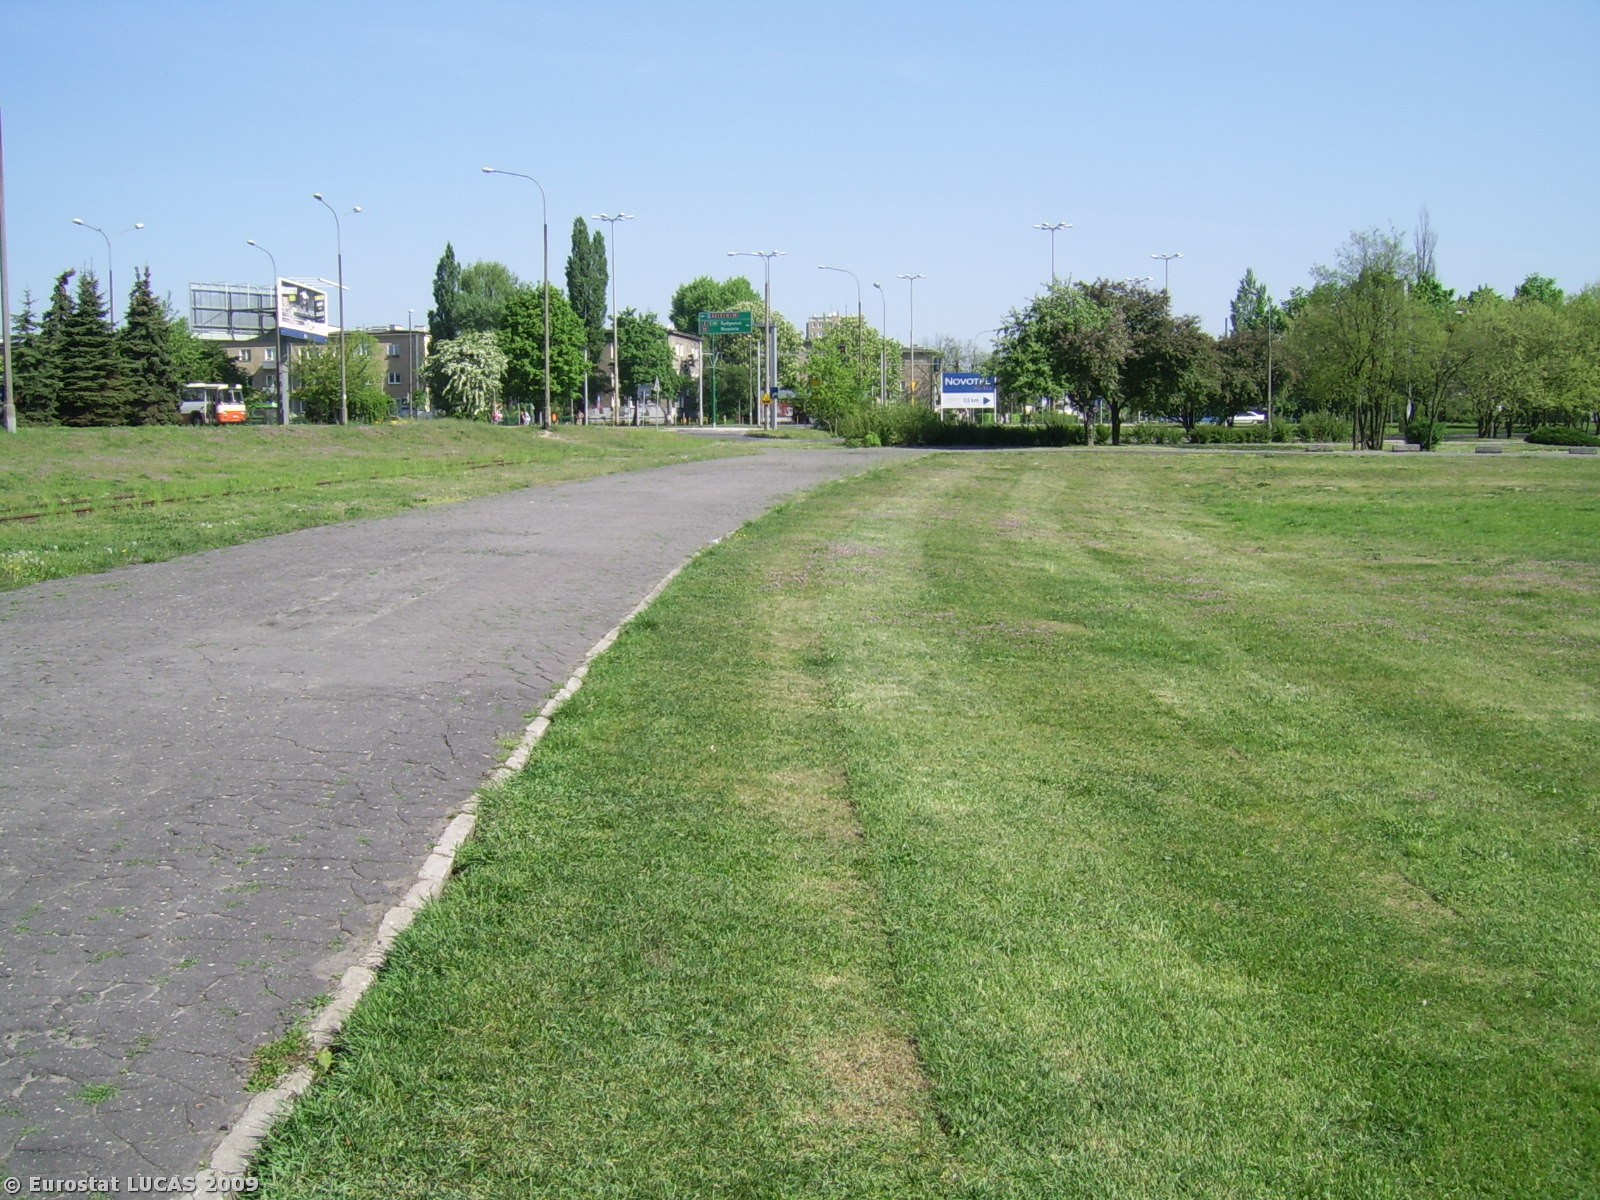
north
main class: Grassland
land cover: Grassland without tree/shrub cover
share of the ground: > 75 %
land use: Amenities, museums, leisure
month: May
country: PL
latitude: 52.4076
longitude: 16.9627
